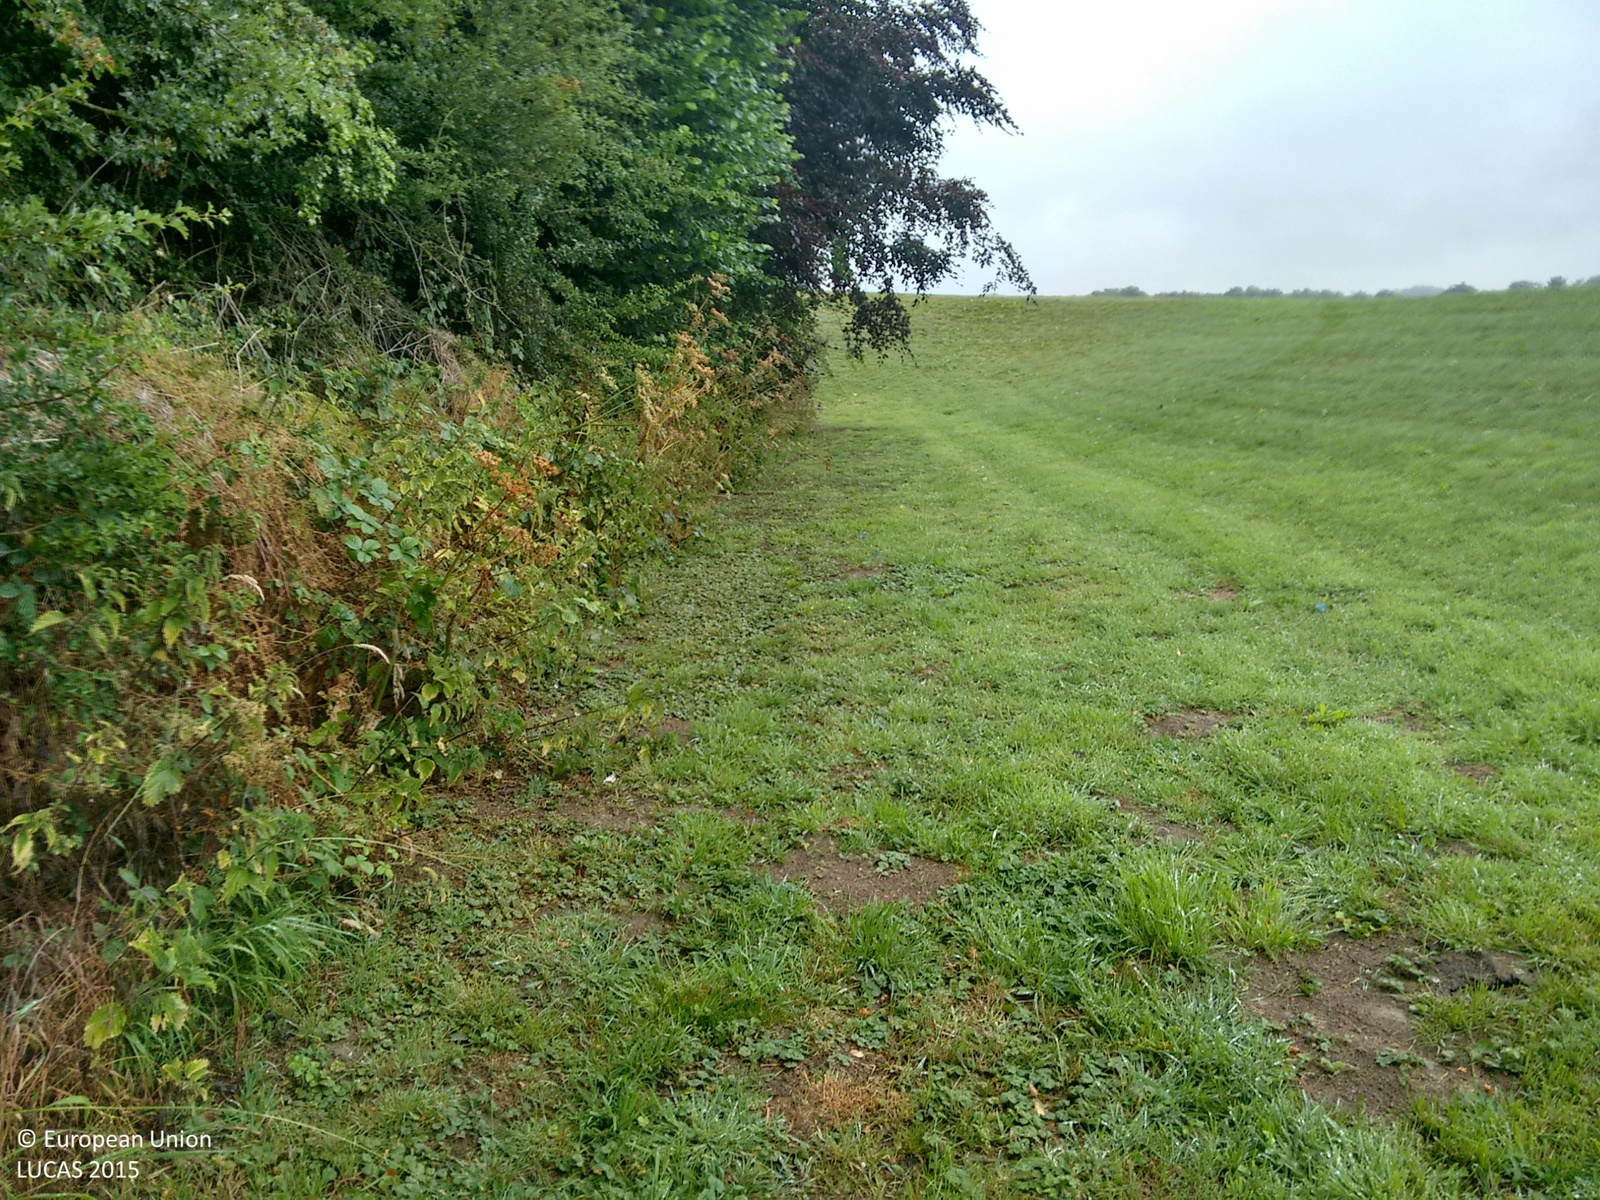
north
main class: Grassland
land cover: Grassland without tree/shrub cover
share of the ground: > 75 %
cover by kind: herbaceous plants 100 %
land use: Agriculture (excluding fallow land and kitchen gardens)
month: July
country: GB
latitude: 52.2456
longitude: -2.7991
